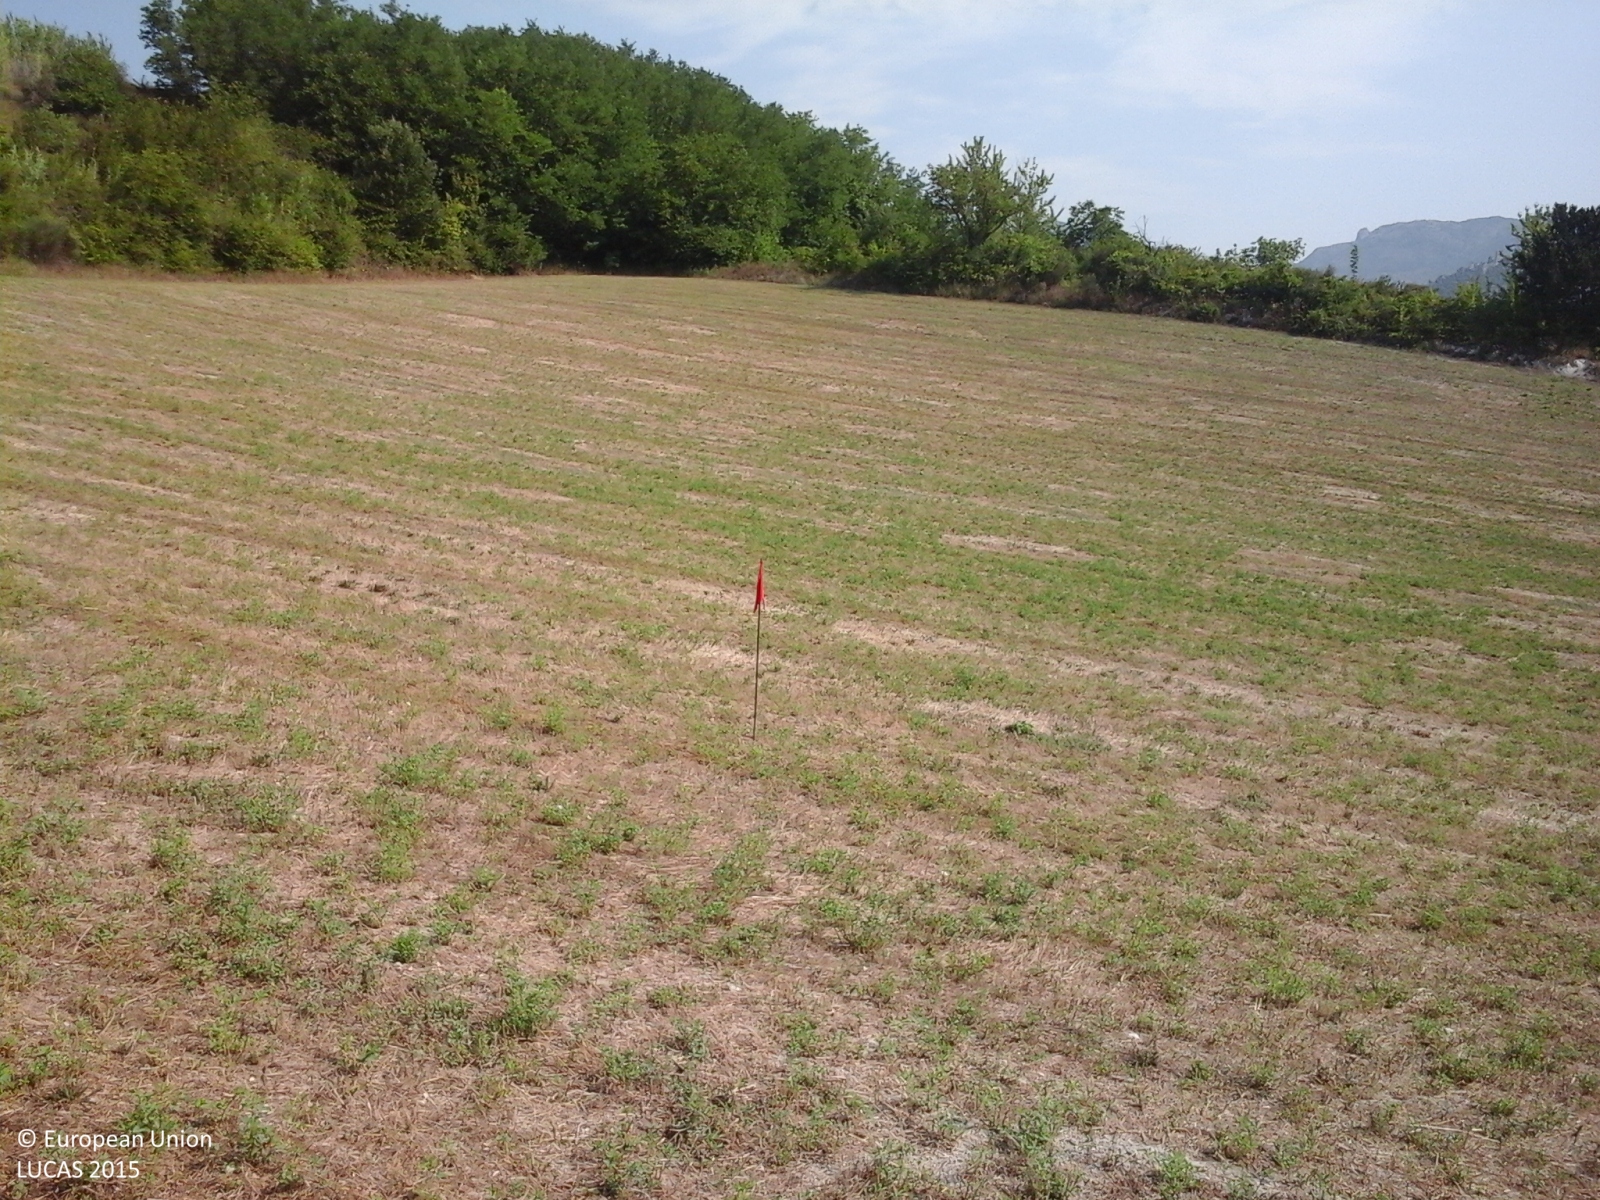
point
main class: Cropland
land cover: Lucerne
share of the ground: > 75 %
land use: Agriculture (excluding fallow land and kitchen gardens)
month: July
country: IT
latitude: 42.1479
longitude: 13.8235
